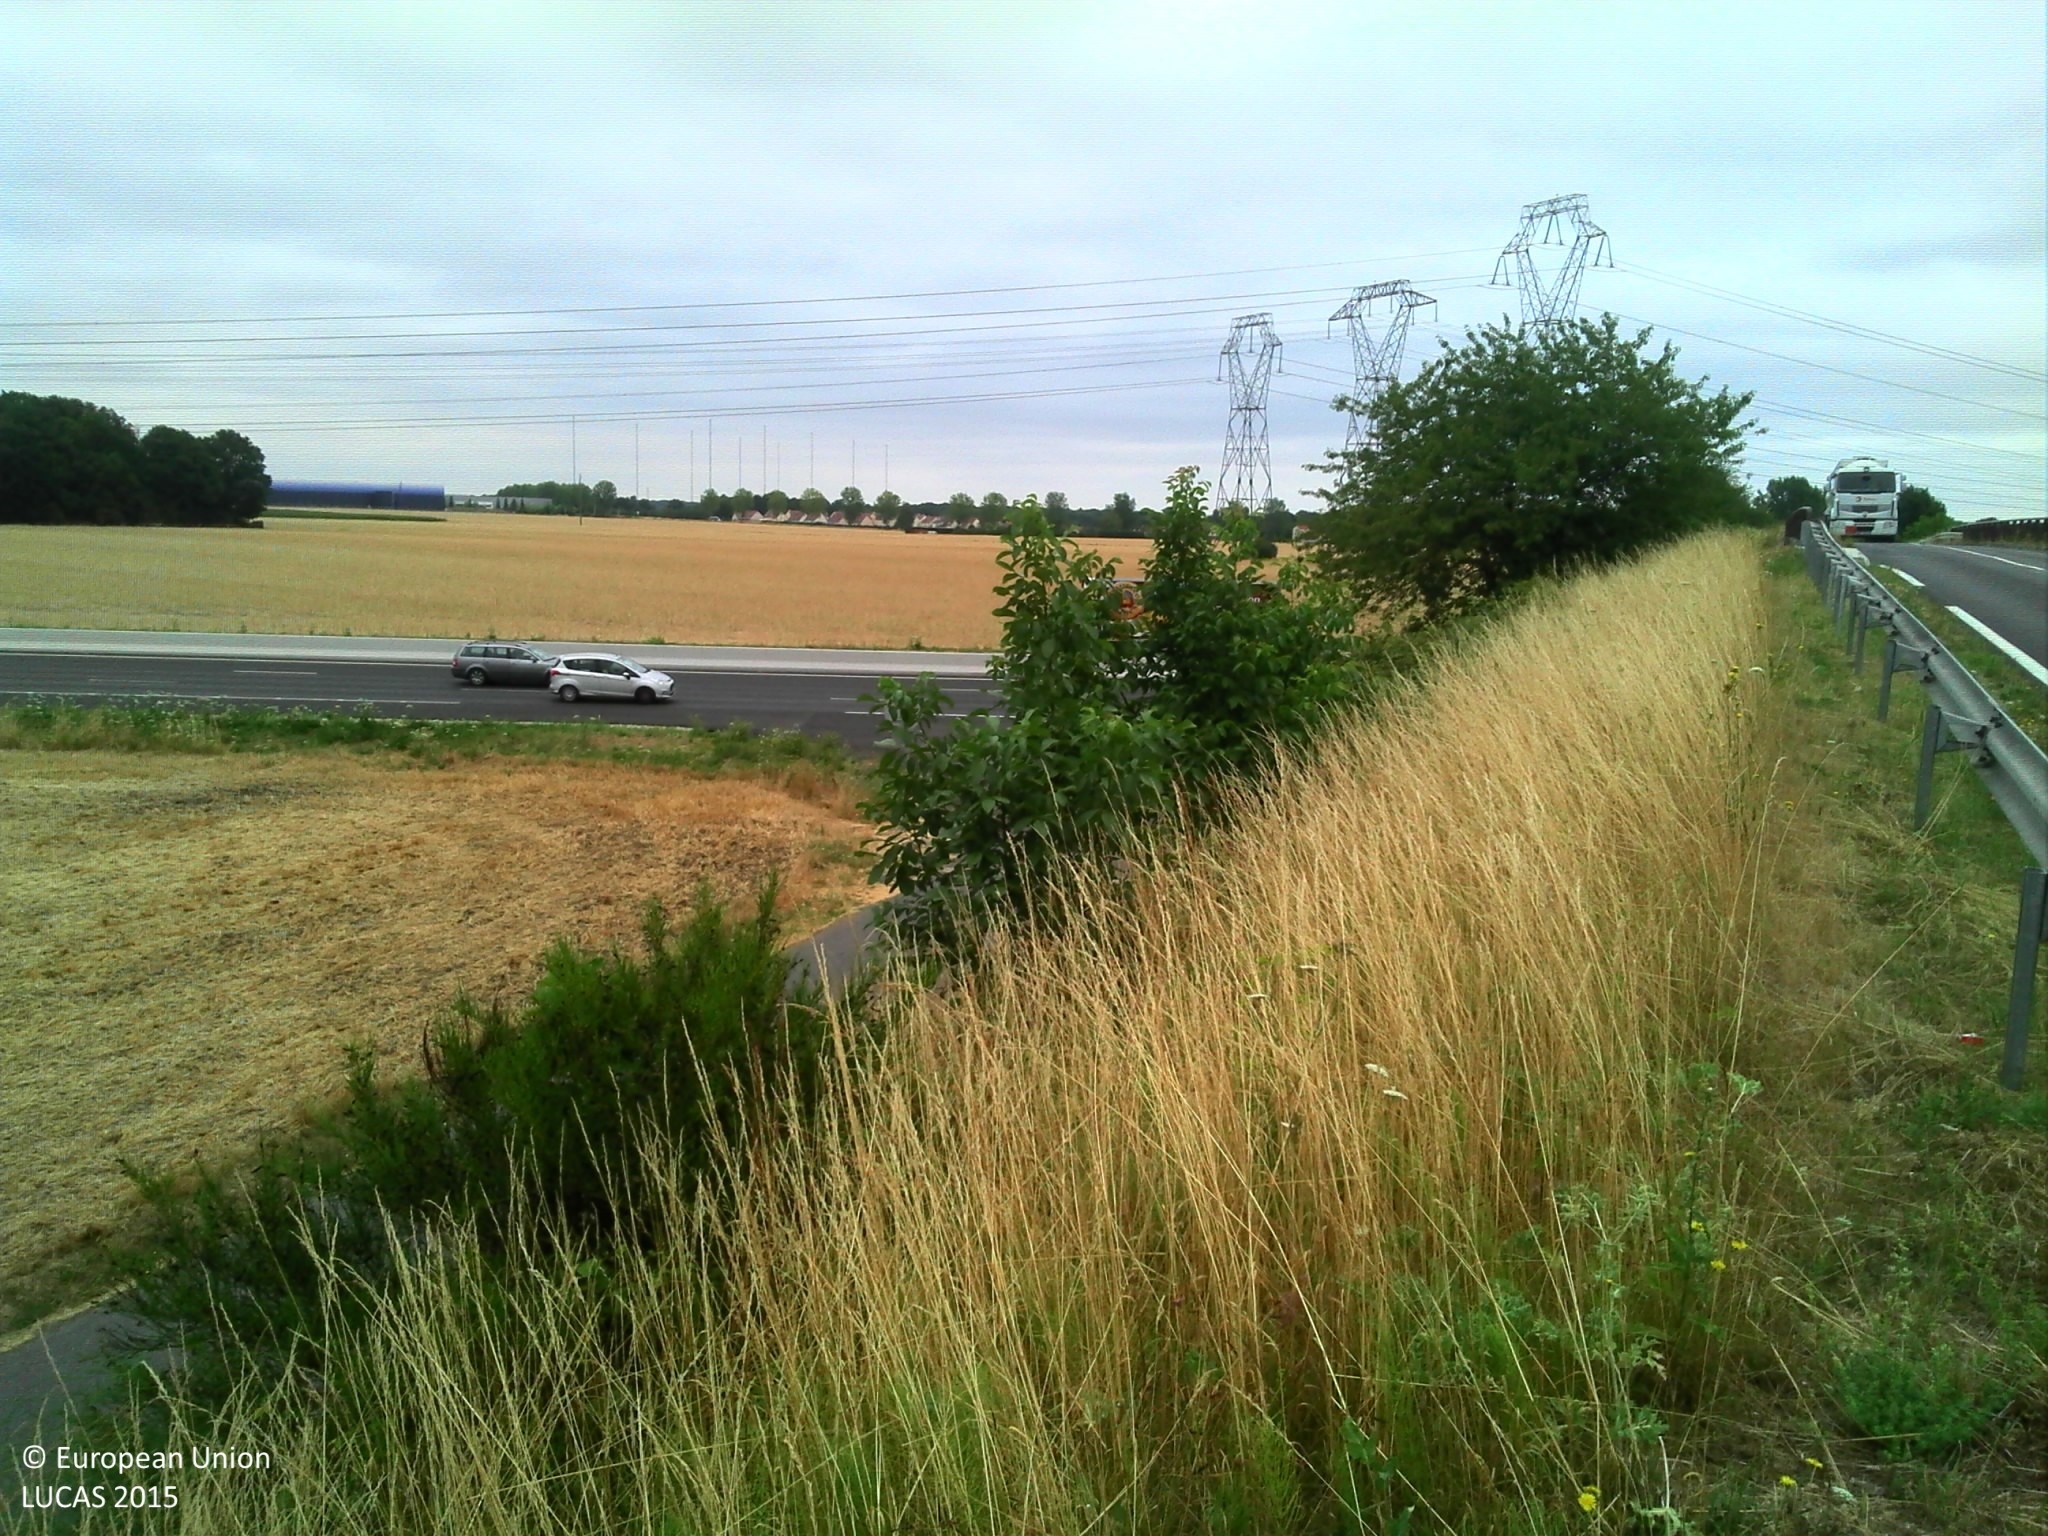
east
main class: Grassland
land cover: Grassland without tree/shrub cover
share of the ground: > 75 %
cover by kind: herbaceous plants 70 %, consolidated bare surface 10 %, unconsolidated bare surface 10 %, shrubs 5 %, lichens and mosses 5 %
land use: Road transport
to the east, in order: Grass margins; Spontaneously vegetated surfaces; Ditches and canals; Paved roads, cycling and walking lanes; Grass margins; Paved roads, cycling and walking lanes; Grass margins; Tracks; Grass margins; Rape and turnip rape; Electric lines; Rape and turnip rape
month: July
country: FR
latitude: 48.5281
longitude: 2.5010
